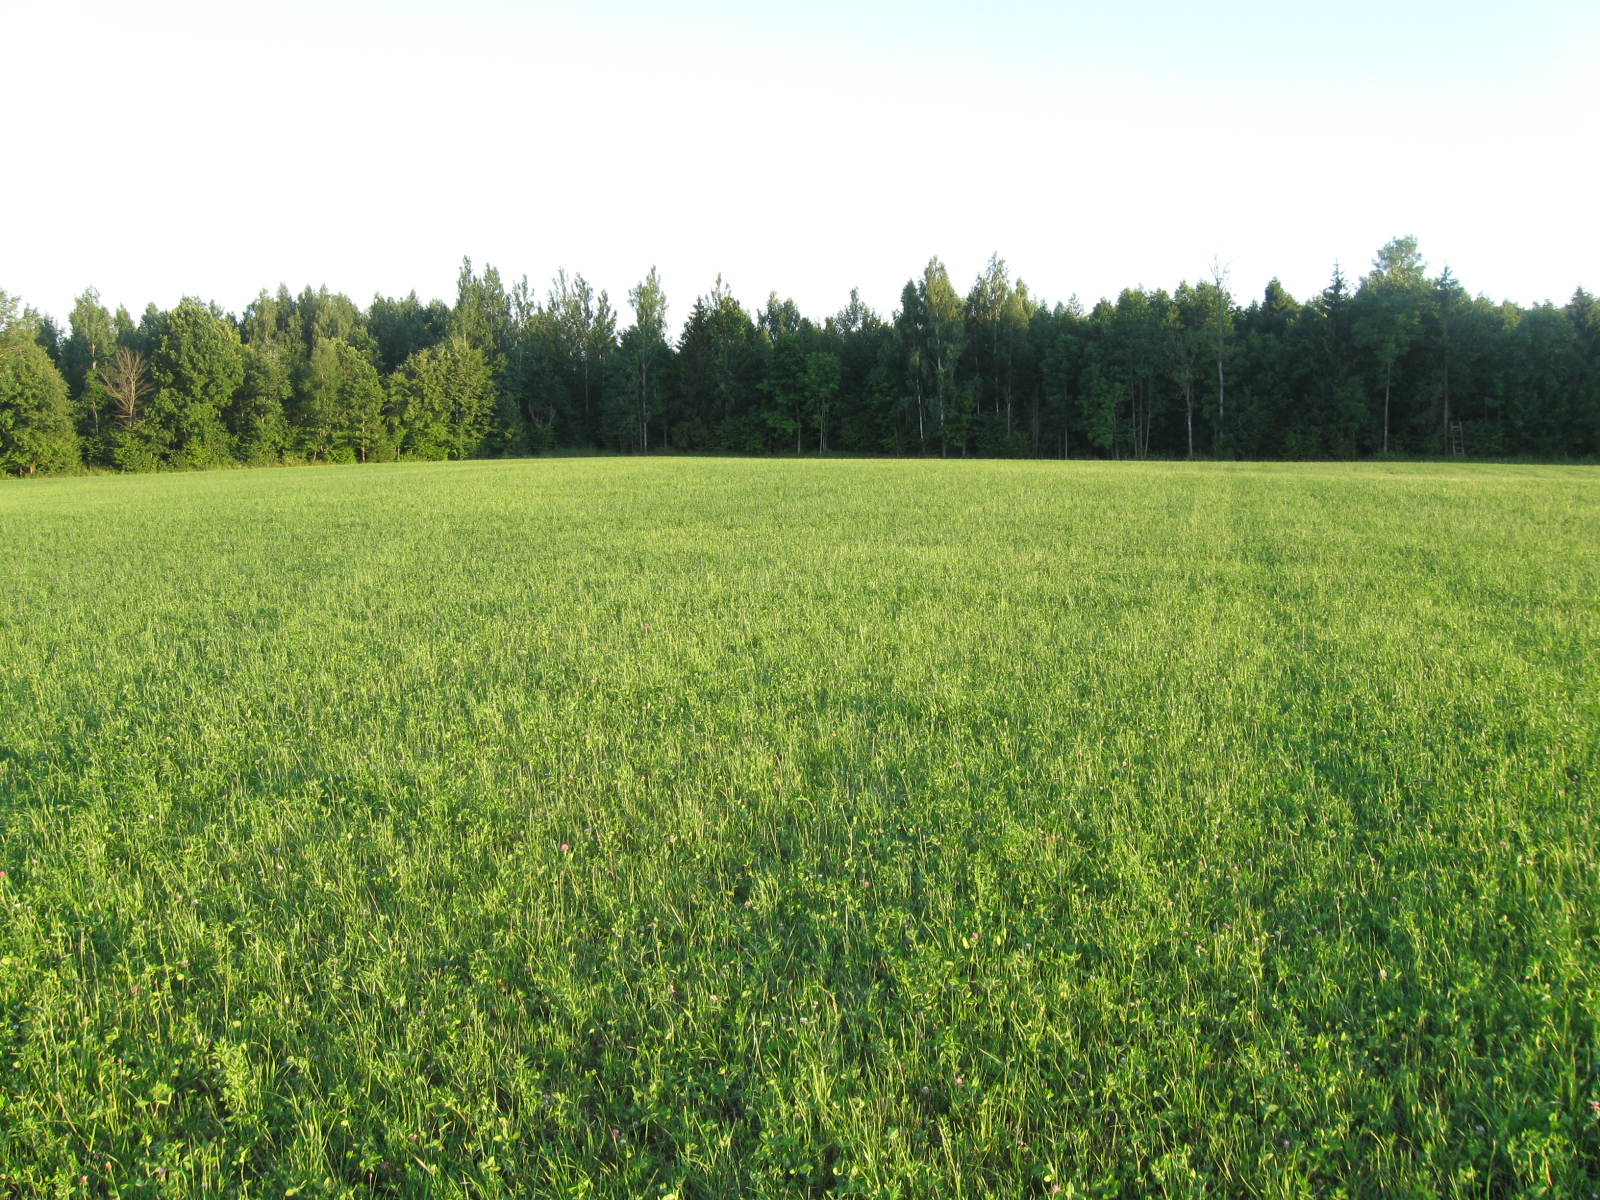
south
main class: Cropland
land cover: Other leguminous and mixtures for fodder
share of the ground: > 75 %
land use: Agriculture (excluding fallow land and kitchen gardens)
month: July
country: LT
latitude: 55.0900
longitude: 23.6360
